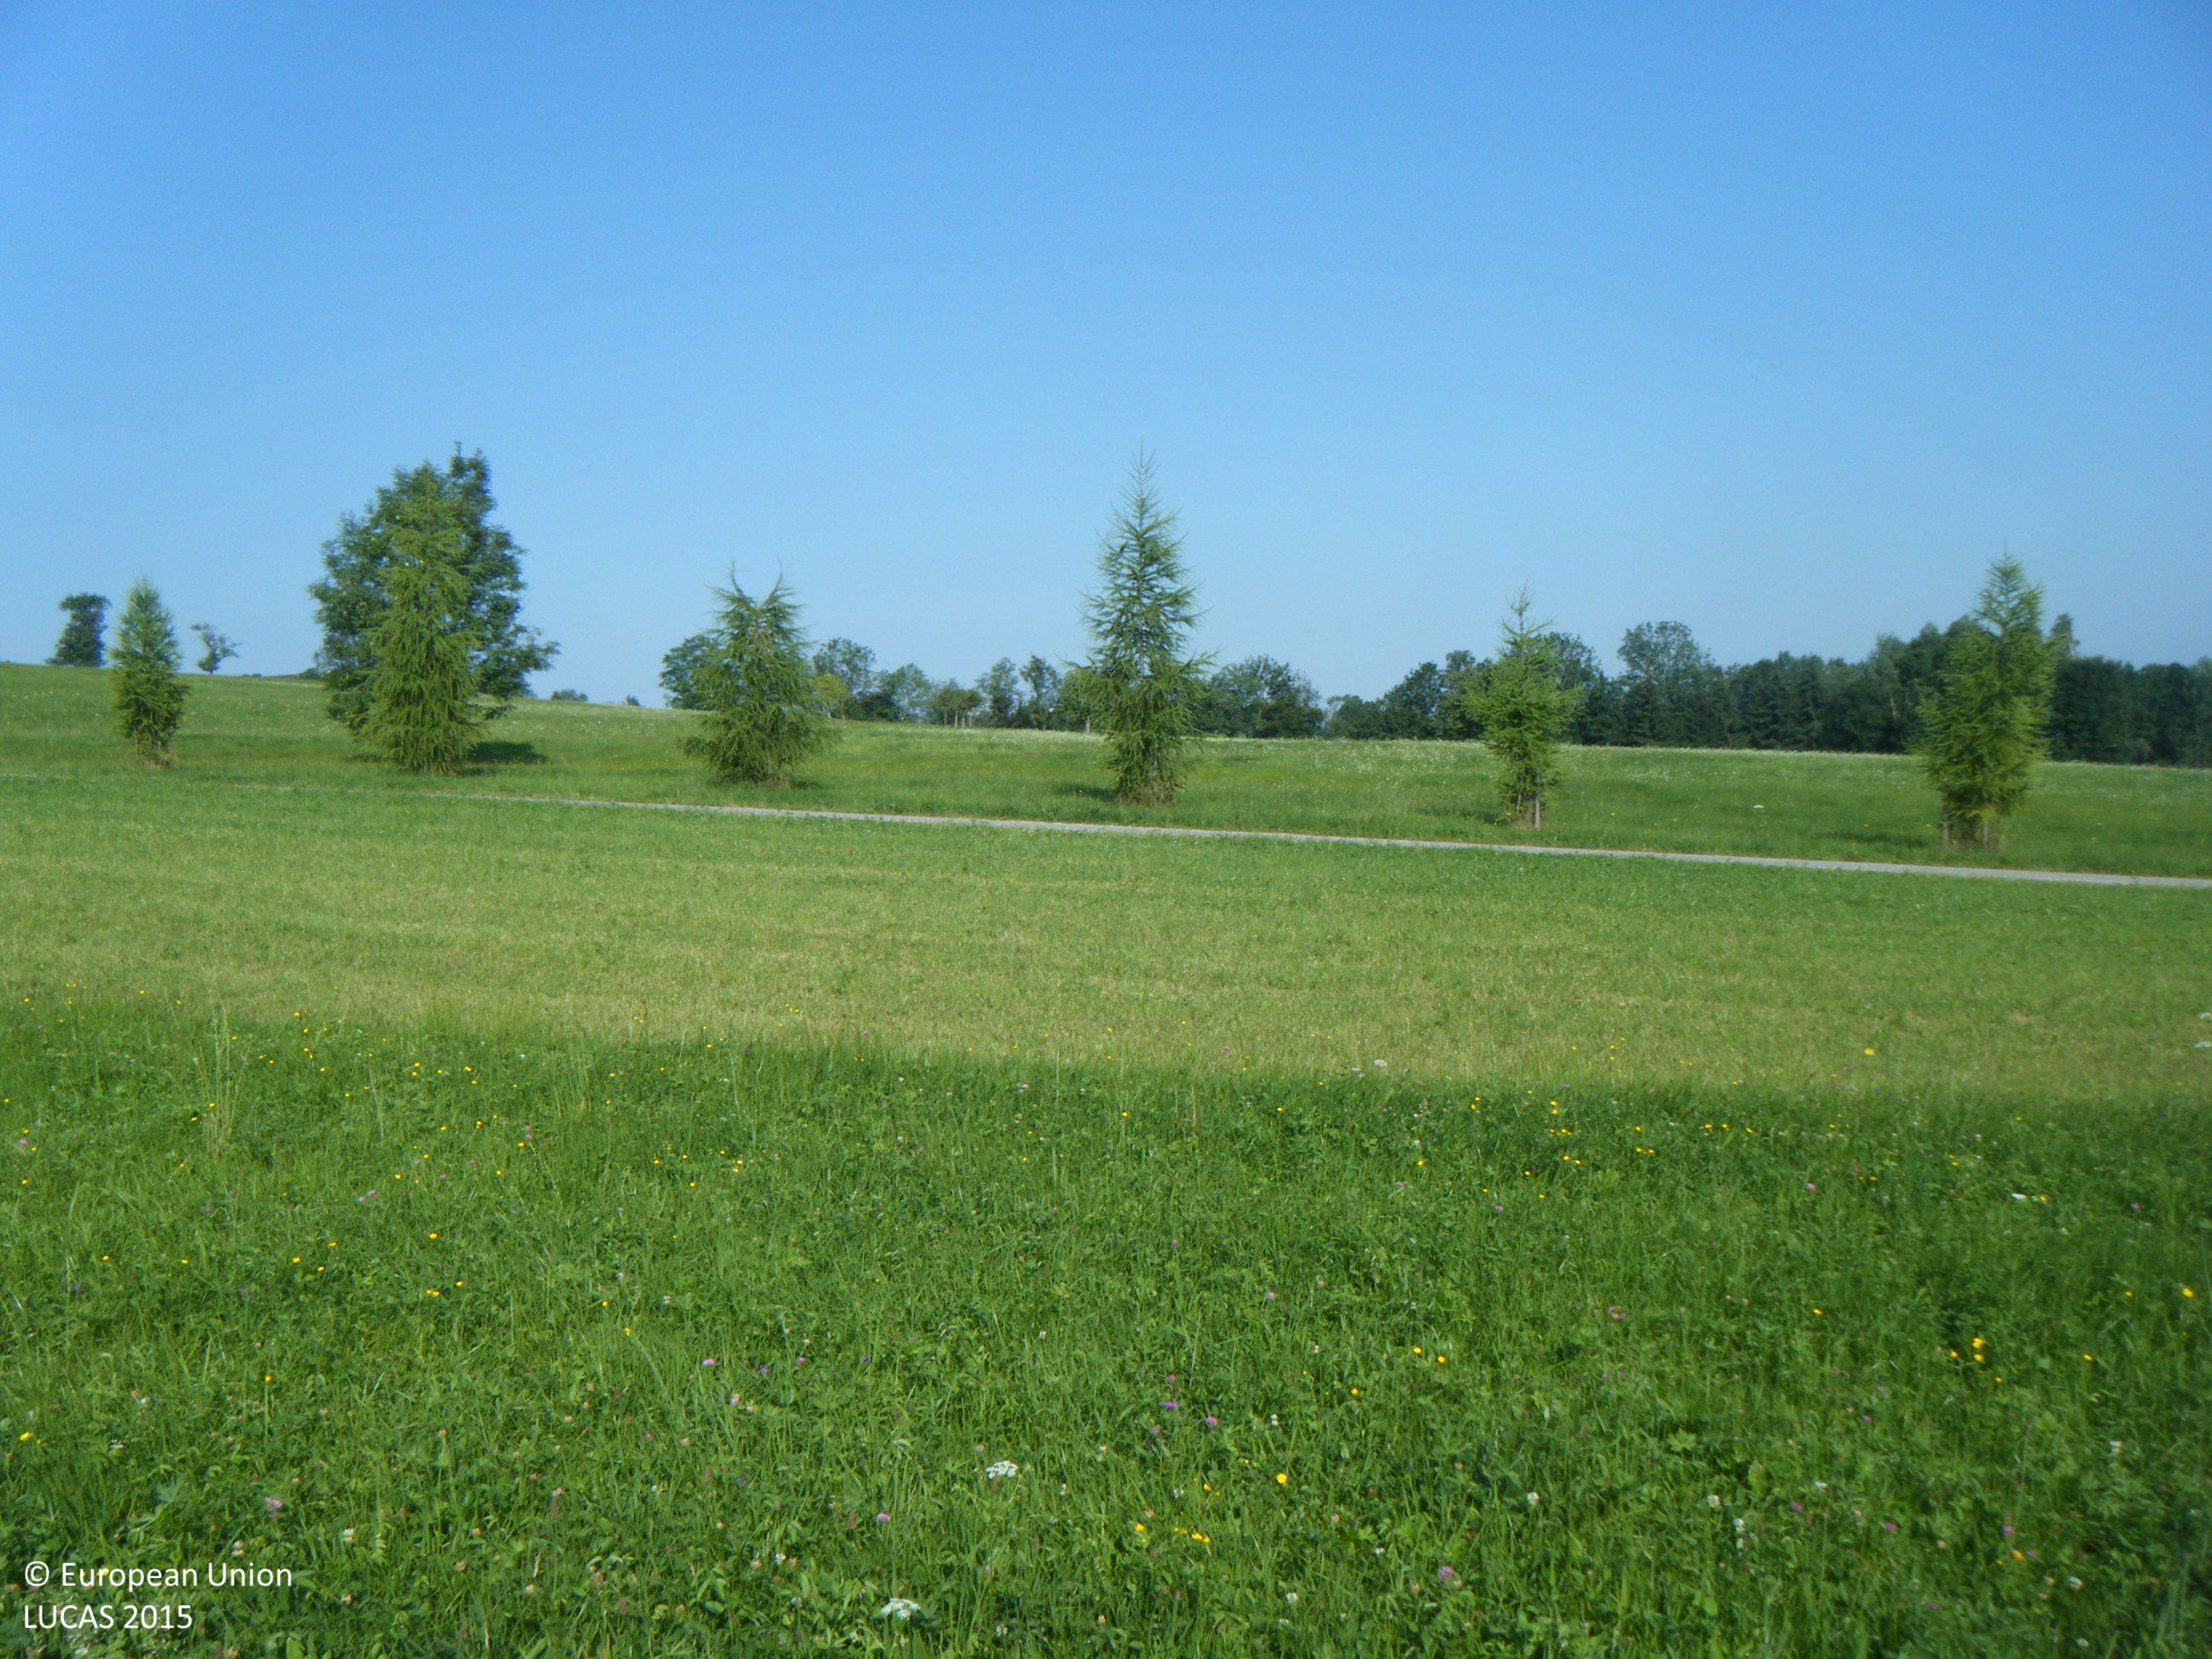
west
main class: Grassland
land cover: Grassland without tree/shrub cover
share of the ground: > 75 %
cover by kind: herbaceous plants 100 %
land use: Agriculture (excluding fallow land and kitchen gardens)
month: July
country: AT
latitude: 47.8981
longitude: 13.4901
